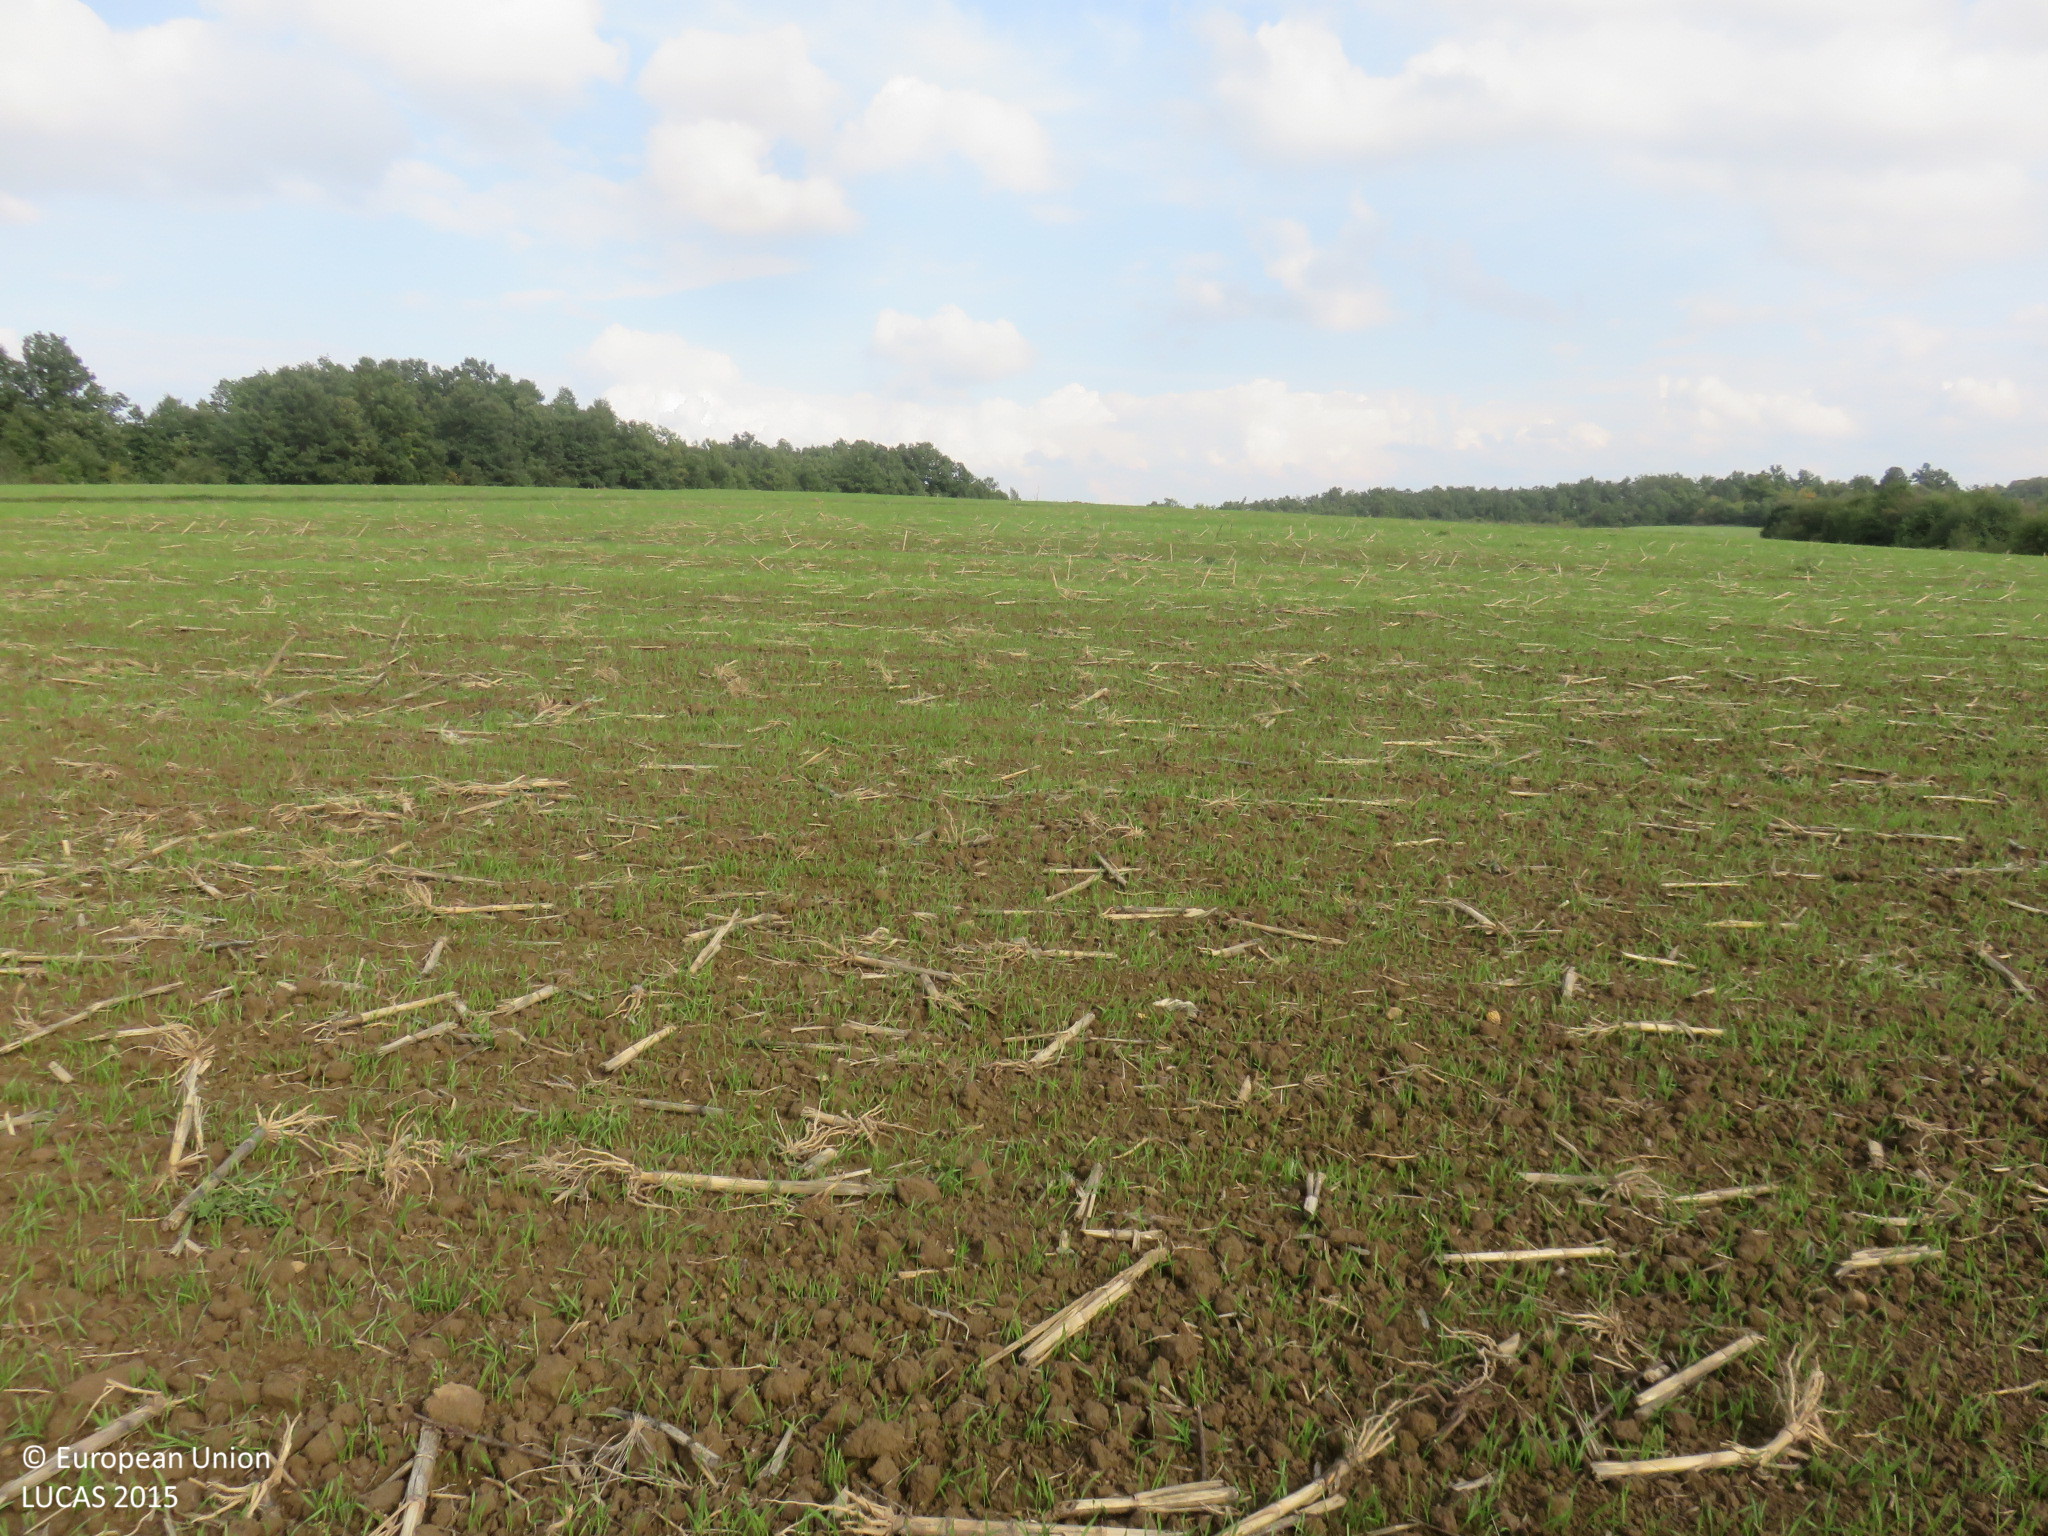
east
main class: Cropland
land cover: Maize
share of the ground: < 10 %
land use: Agriculture (excluding fallow land and kitchen gardens)
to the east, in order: Maize; Electric lines; Maize; Grass margins; Tracks; Grass margins; Maize
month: October
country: BG
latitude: 42.9392
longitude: 25.3788
